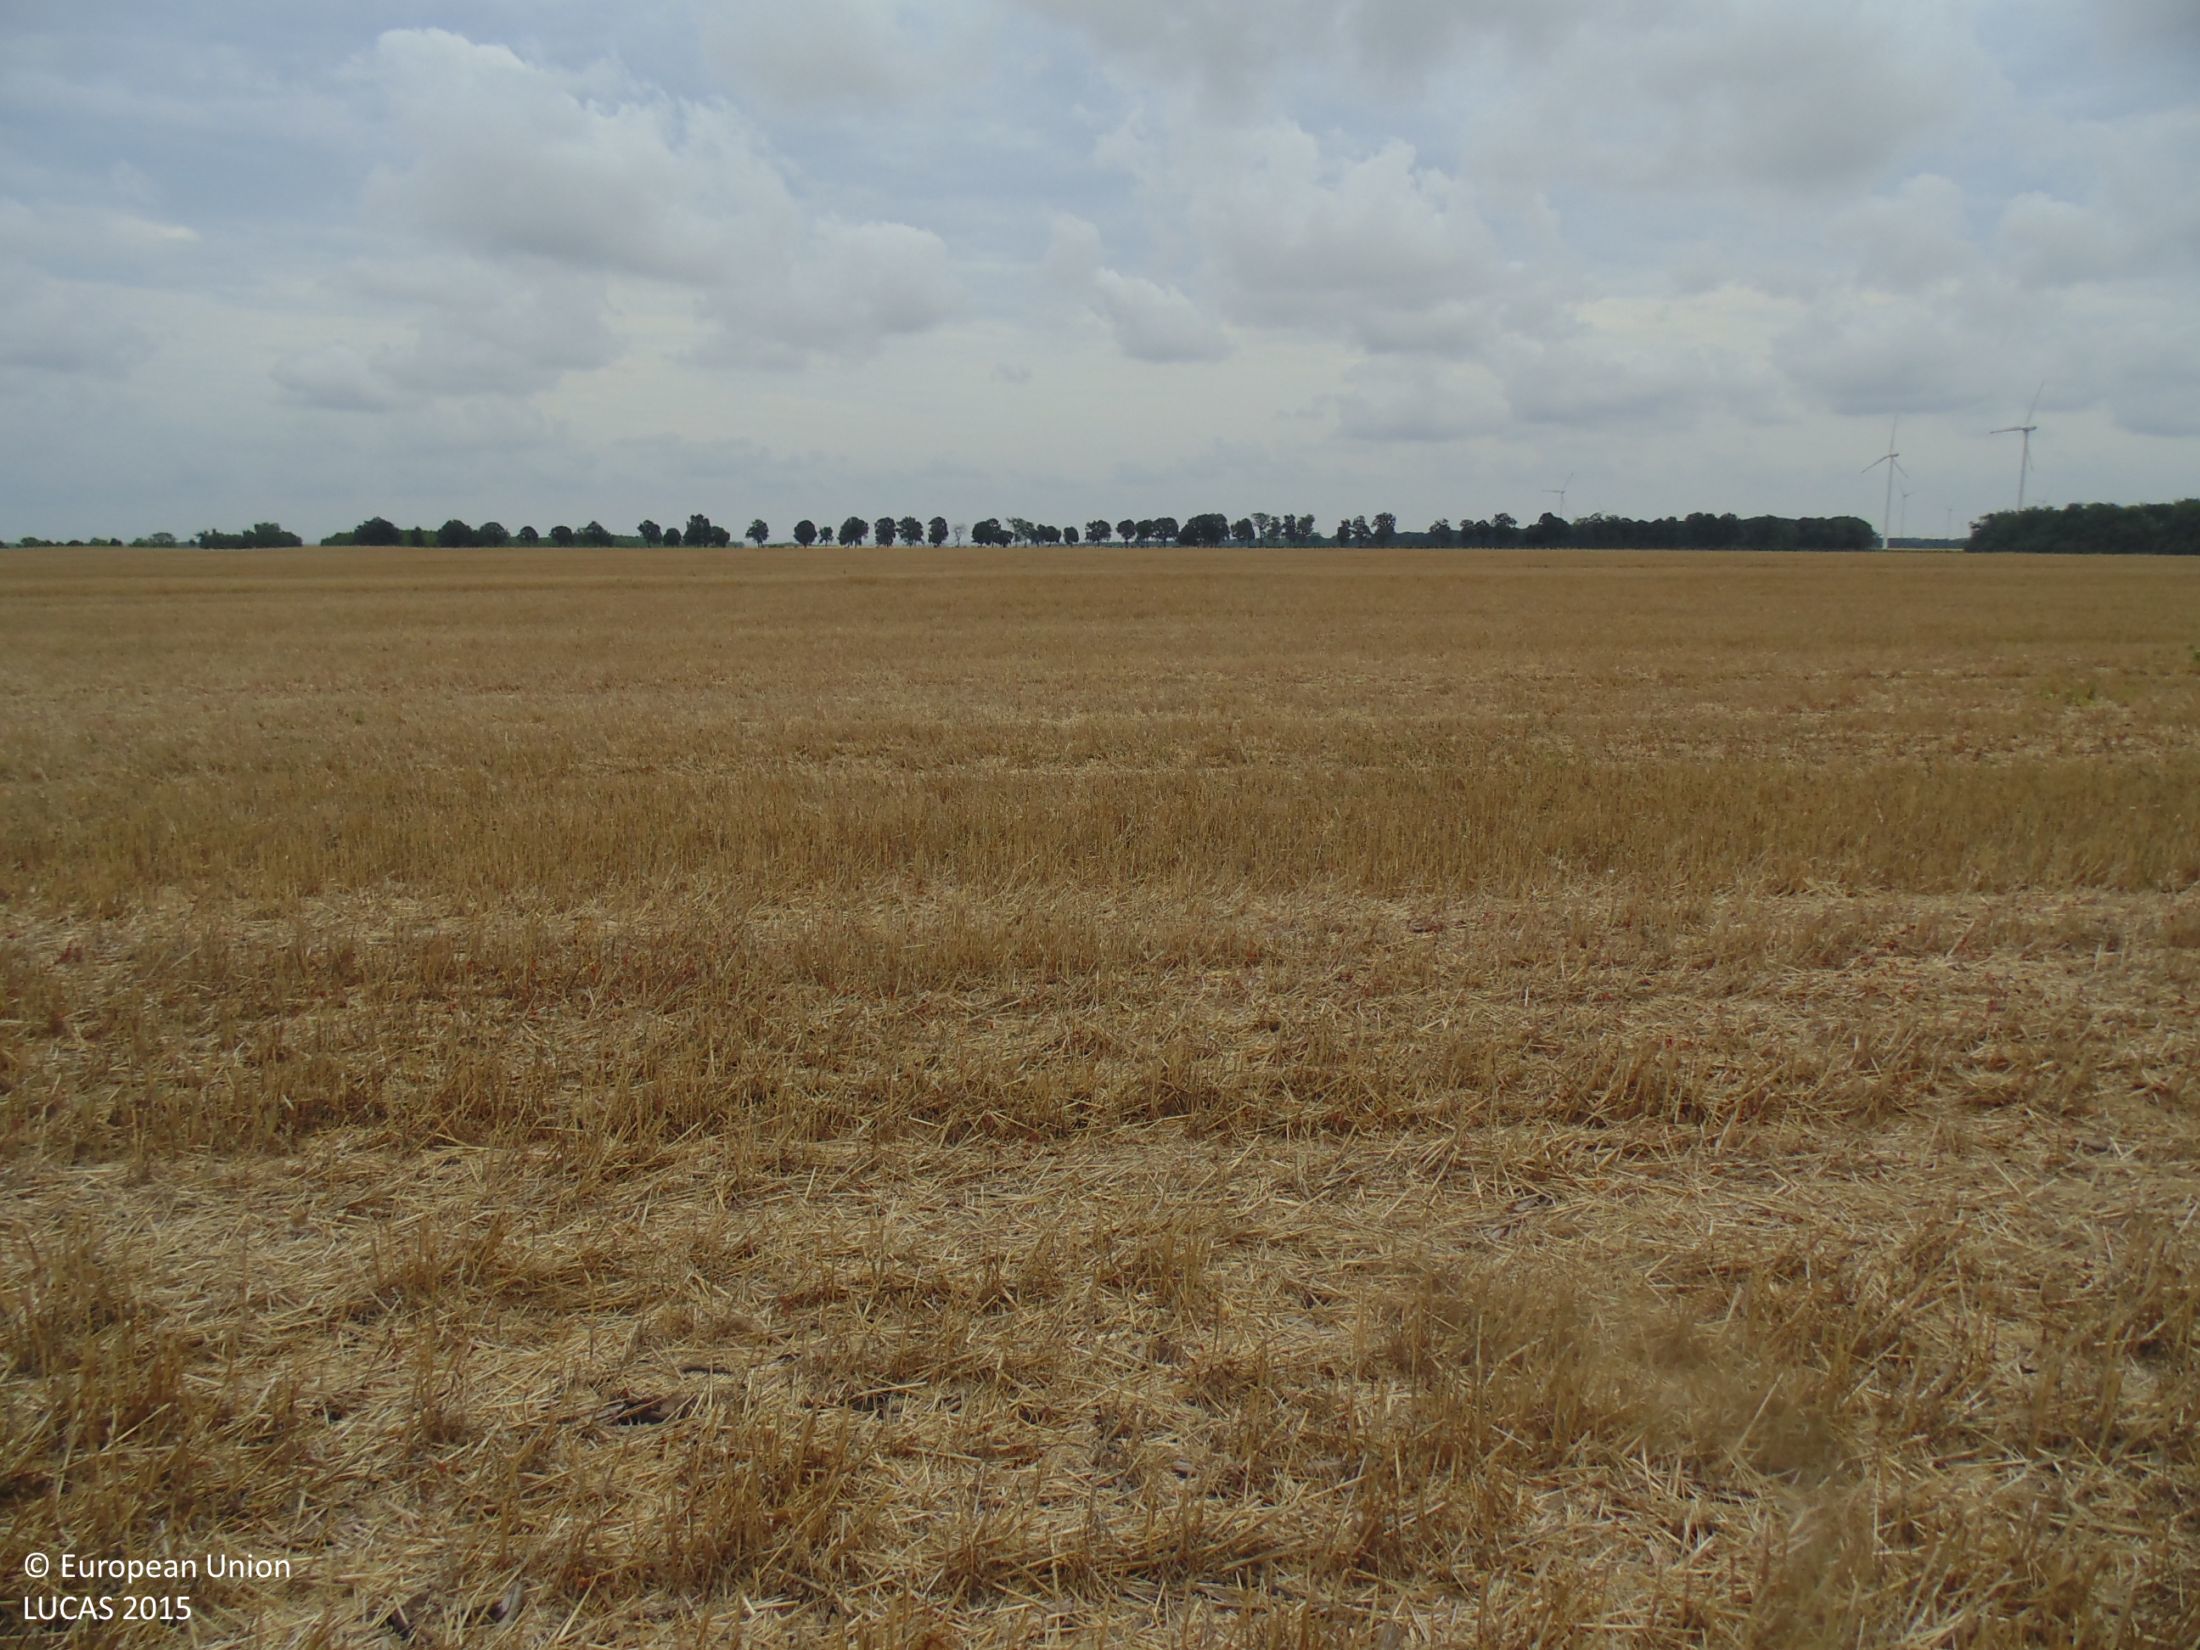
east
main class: Cropland
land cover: Common wheat
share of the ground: 50 - 75 %
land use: Agriculture (excluding fallow land and kitchen gardens)
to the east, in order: Common wheat
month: August
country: BG
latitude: 43.5654
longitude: 28.4467
